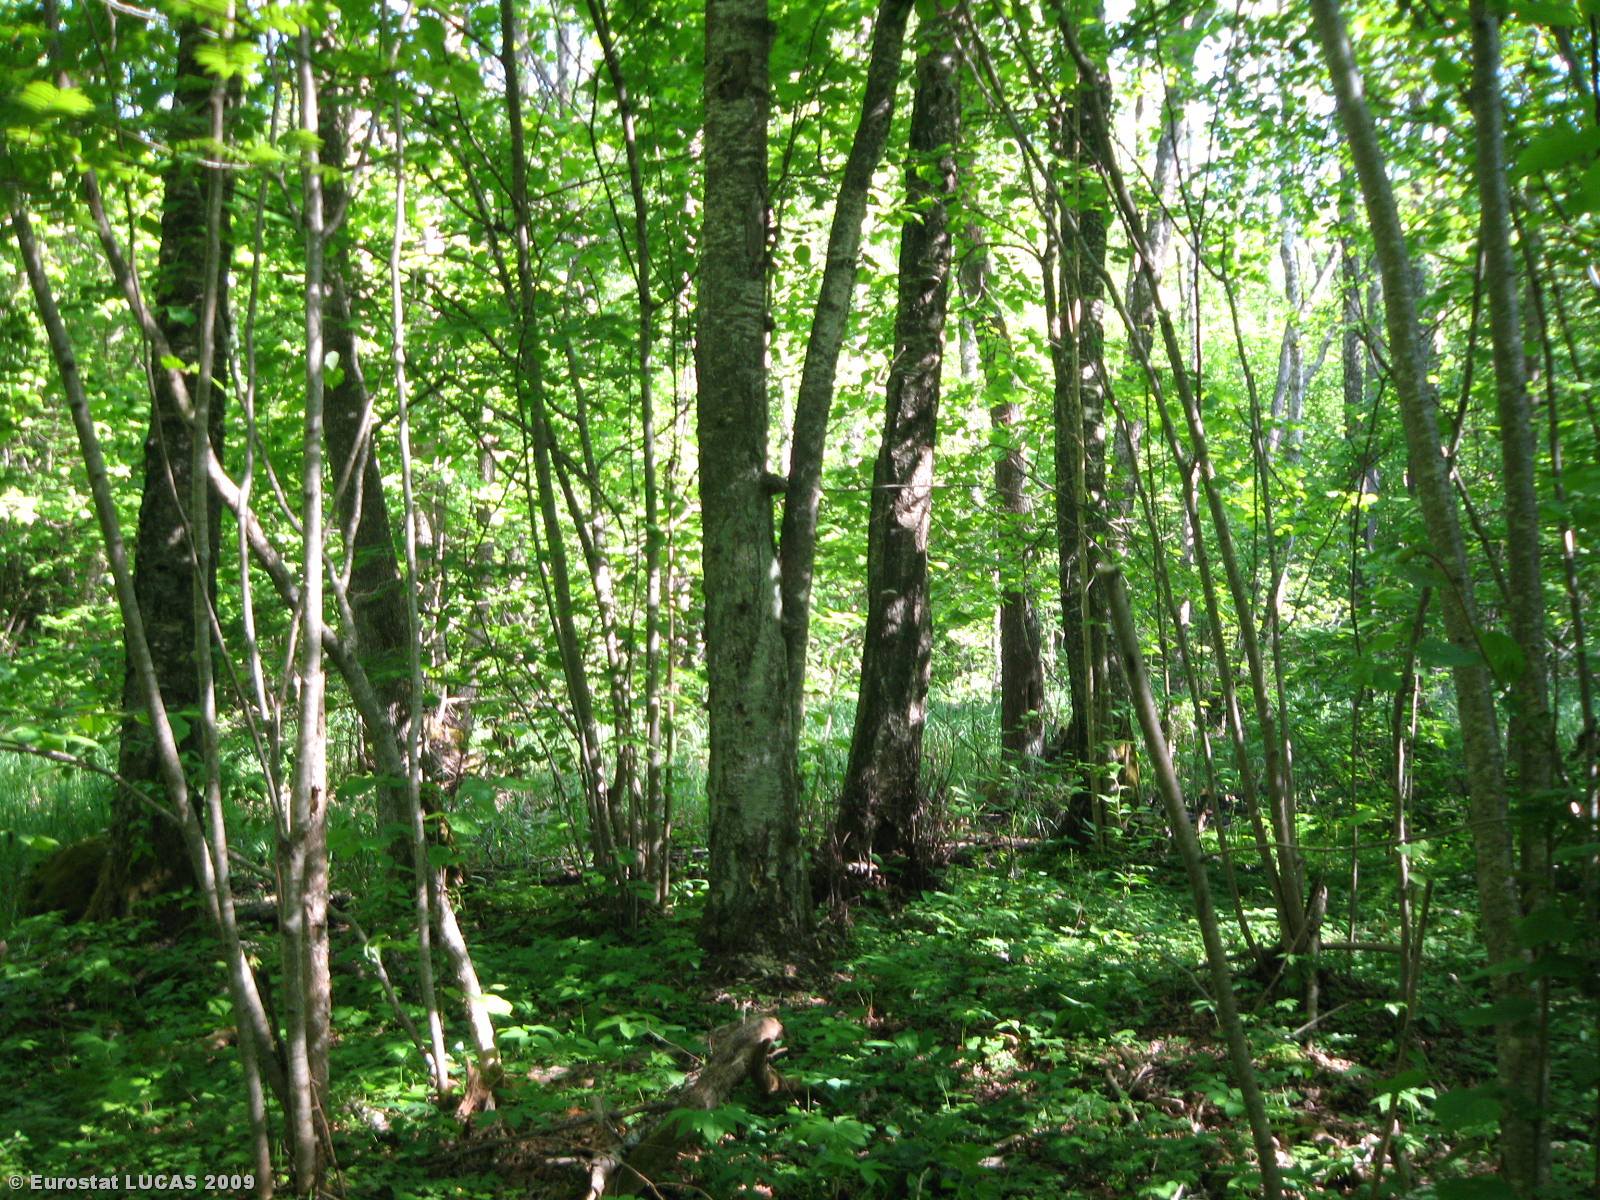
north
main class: Woodland
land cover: Broadleaved woodland
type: non-riverine alder, birch or aspen forest
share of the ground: > 75 %
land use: Forestry
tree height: > 5 m
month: May
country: LT
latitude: 55.7904
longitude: 24.0765
